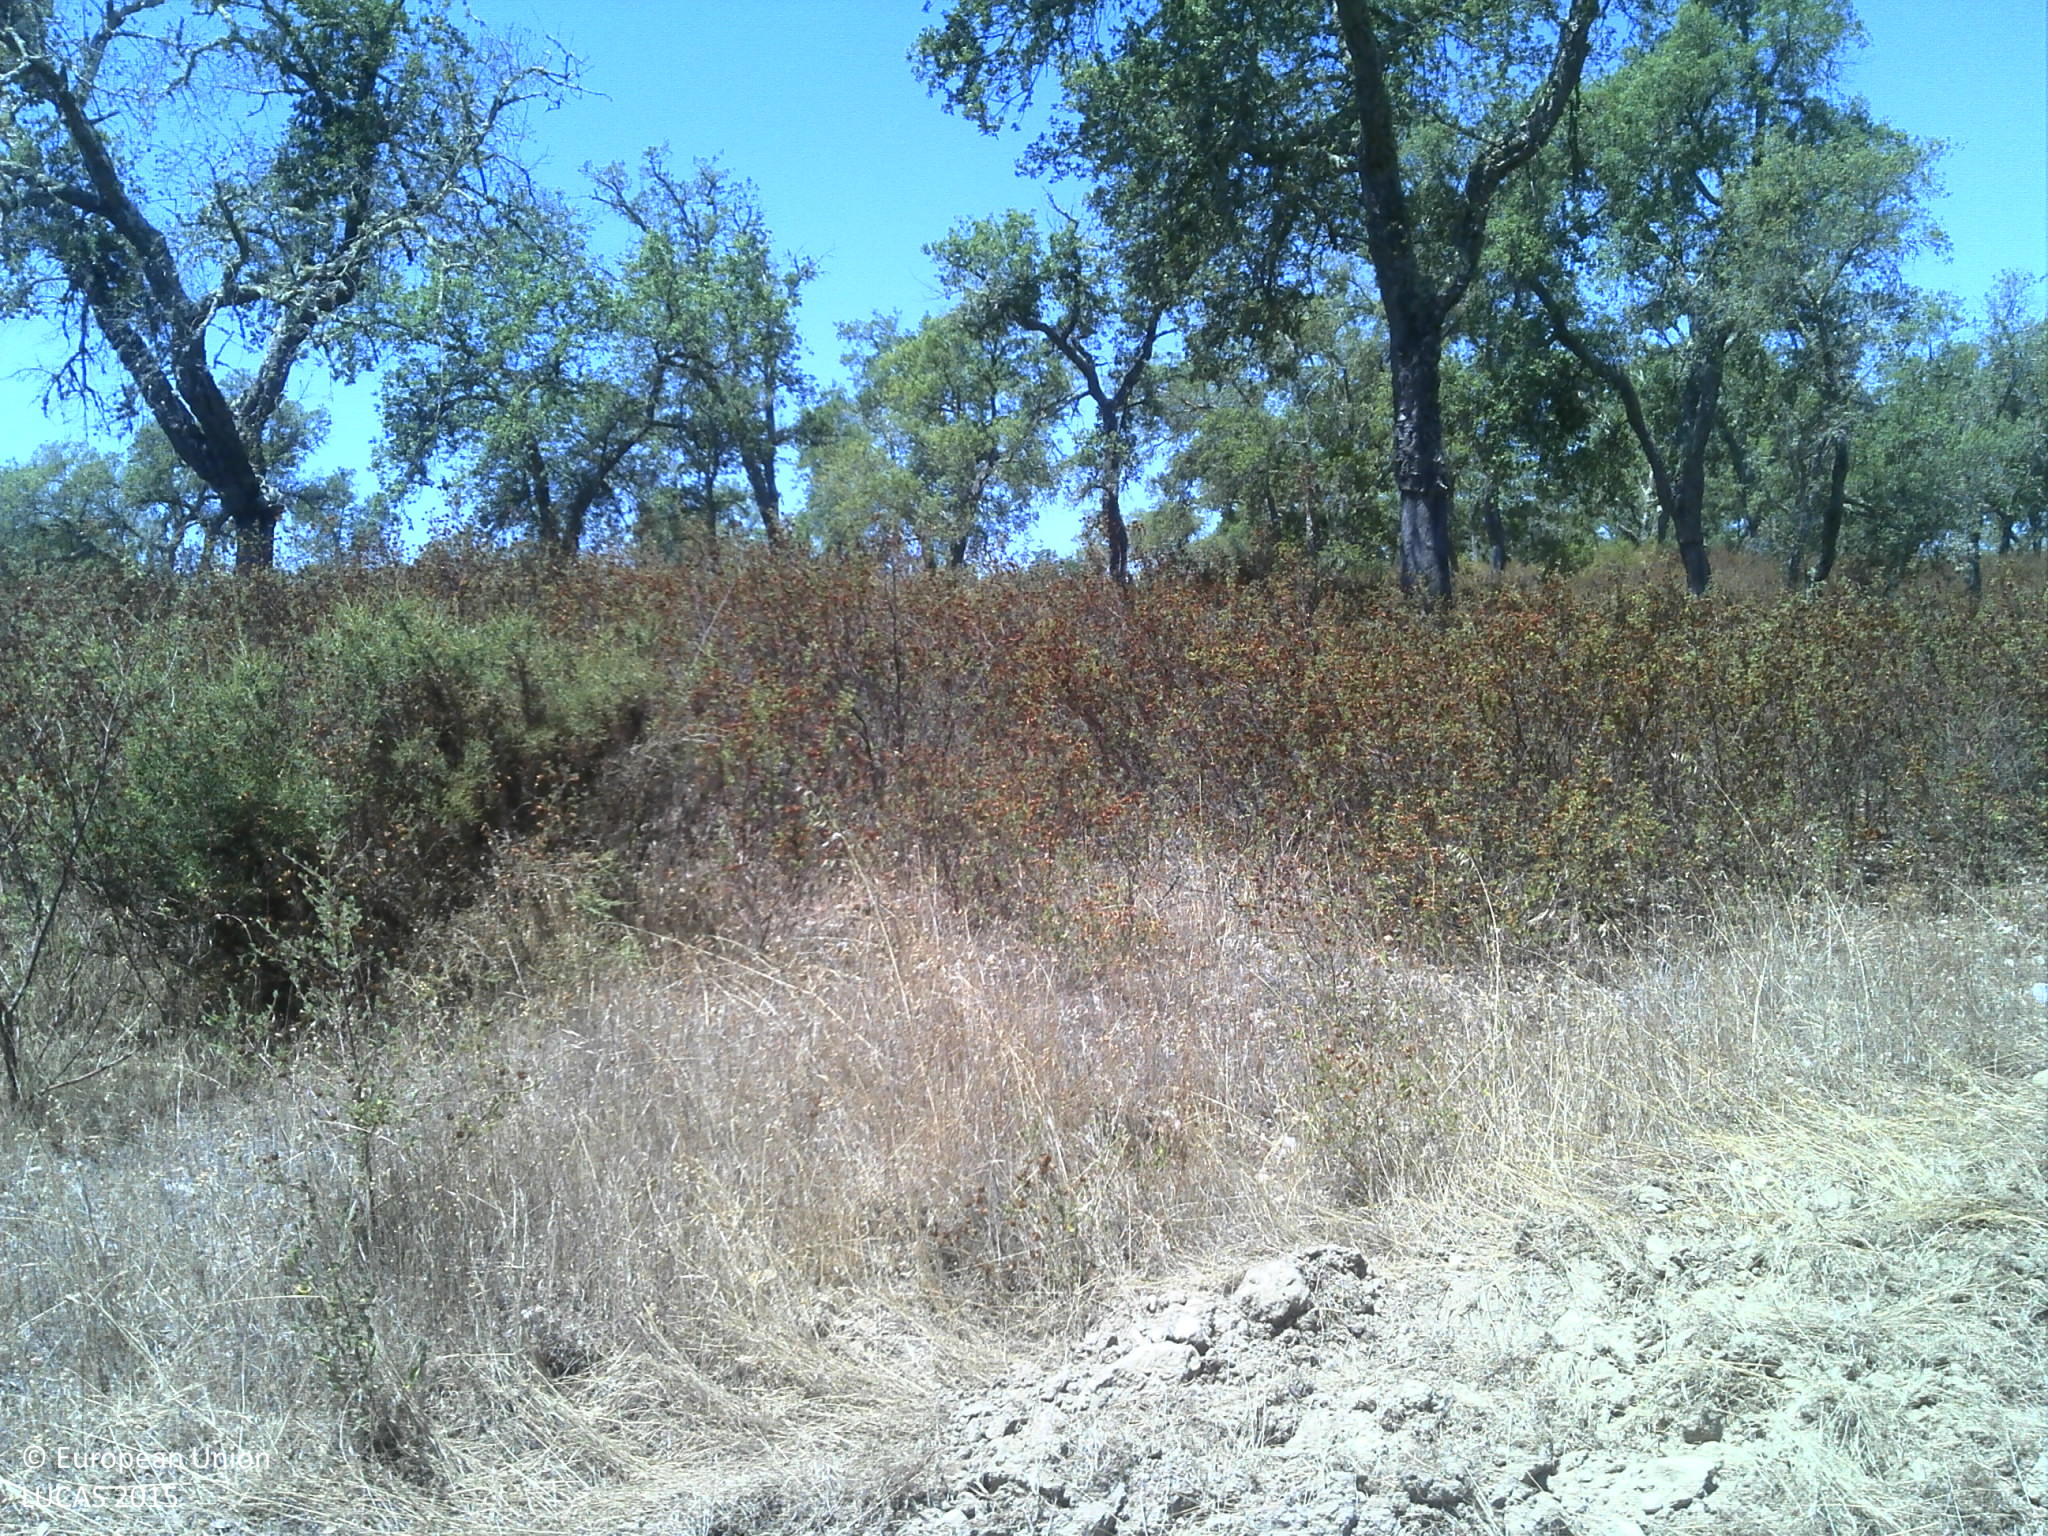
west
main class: Woodland
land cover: Broadleaved woodland
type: broadleaved evergreen forest
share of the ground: 25 - 50 %
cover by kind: unconsolidated bare surface 40 %, broadleaved forest trees 35 %, shrubs 15 %, herbaceous plants 10 %
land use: Forestry
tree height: > 5 m
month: July
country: PT
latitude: 39.0293
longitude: -8.2979
